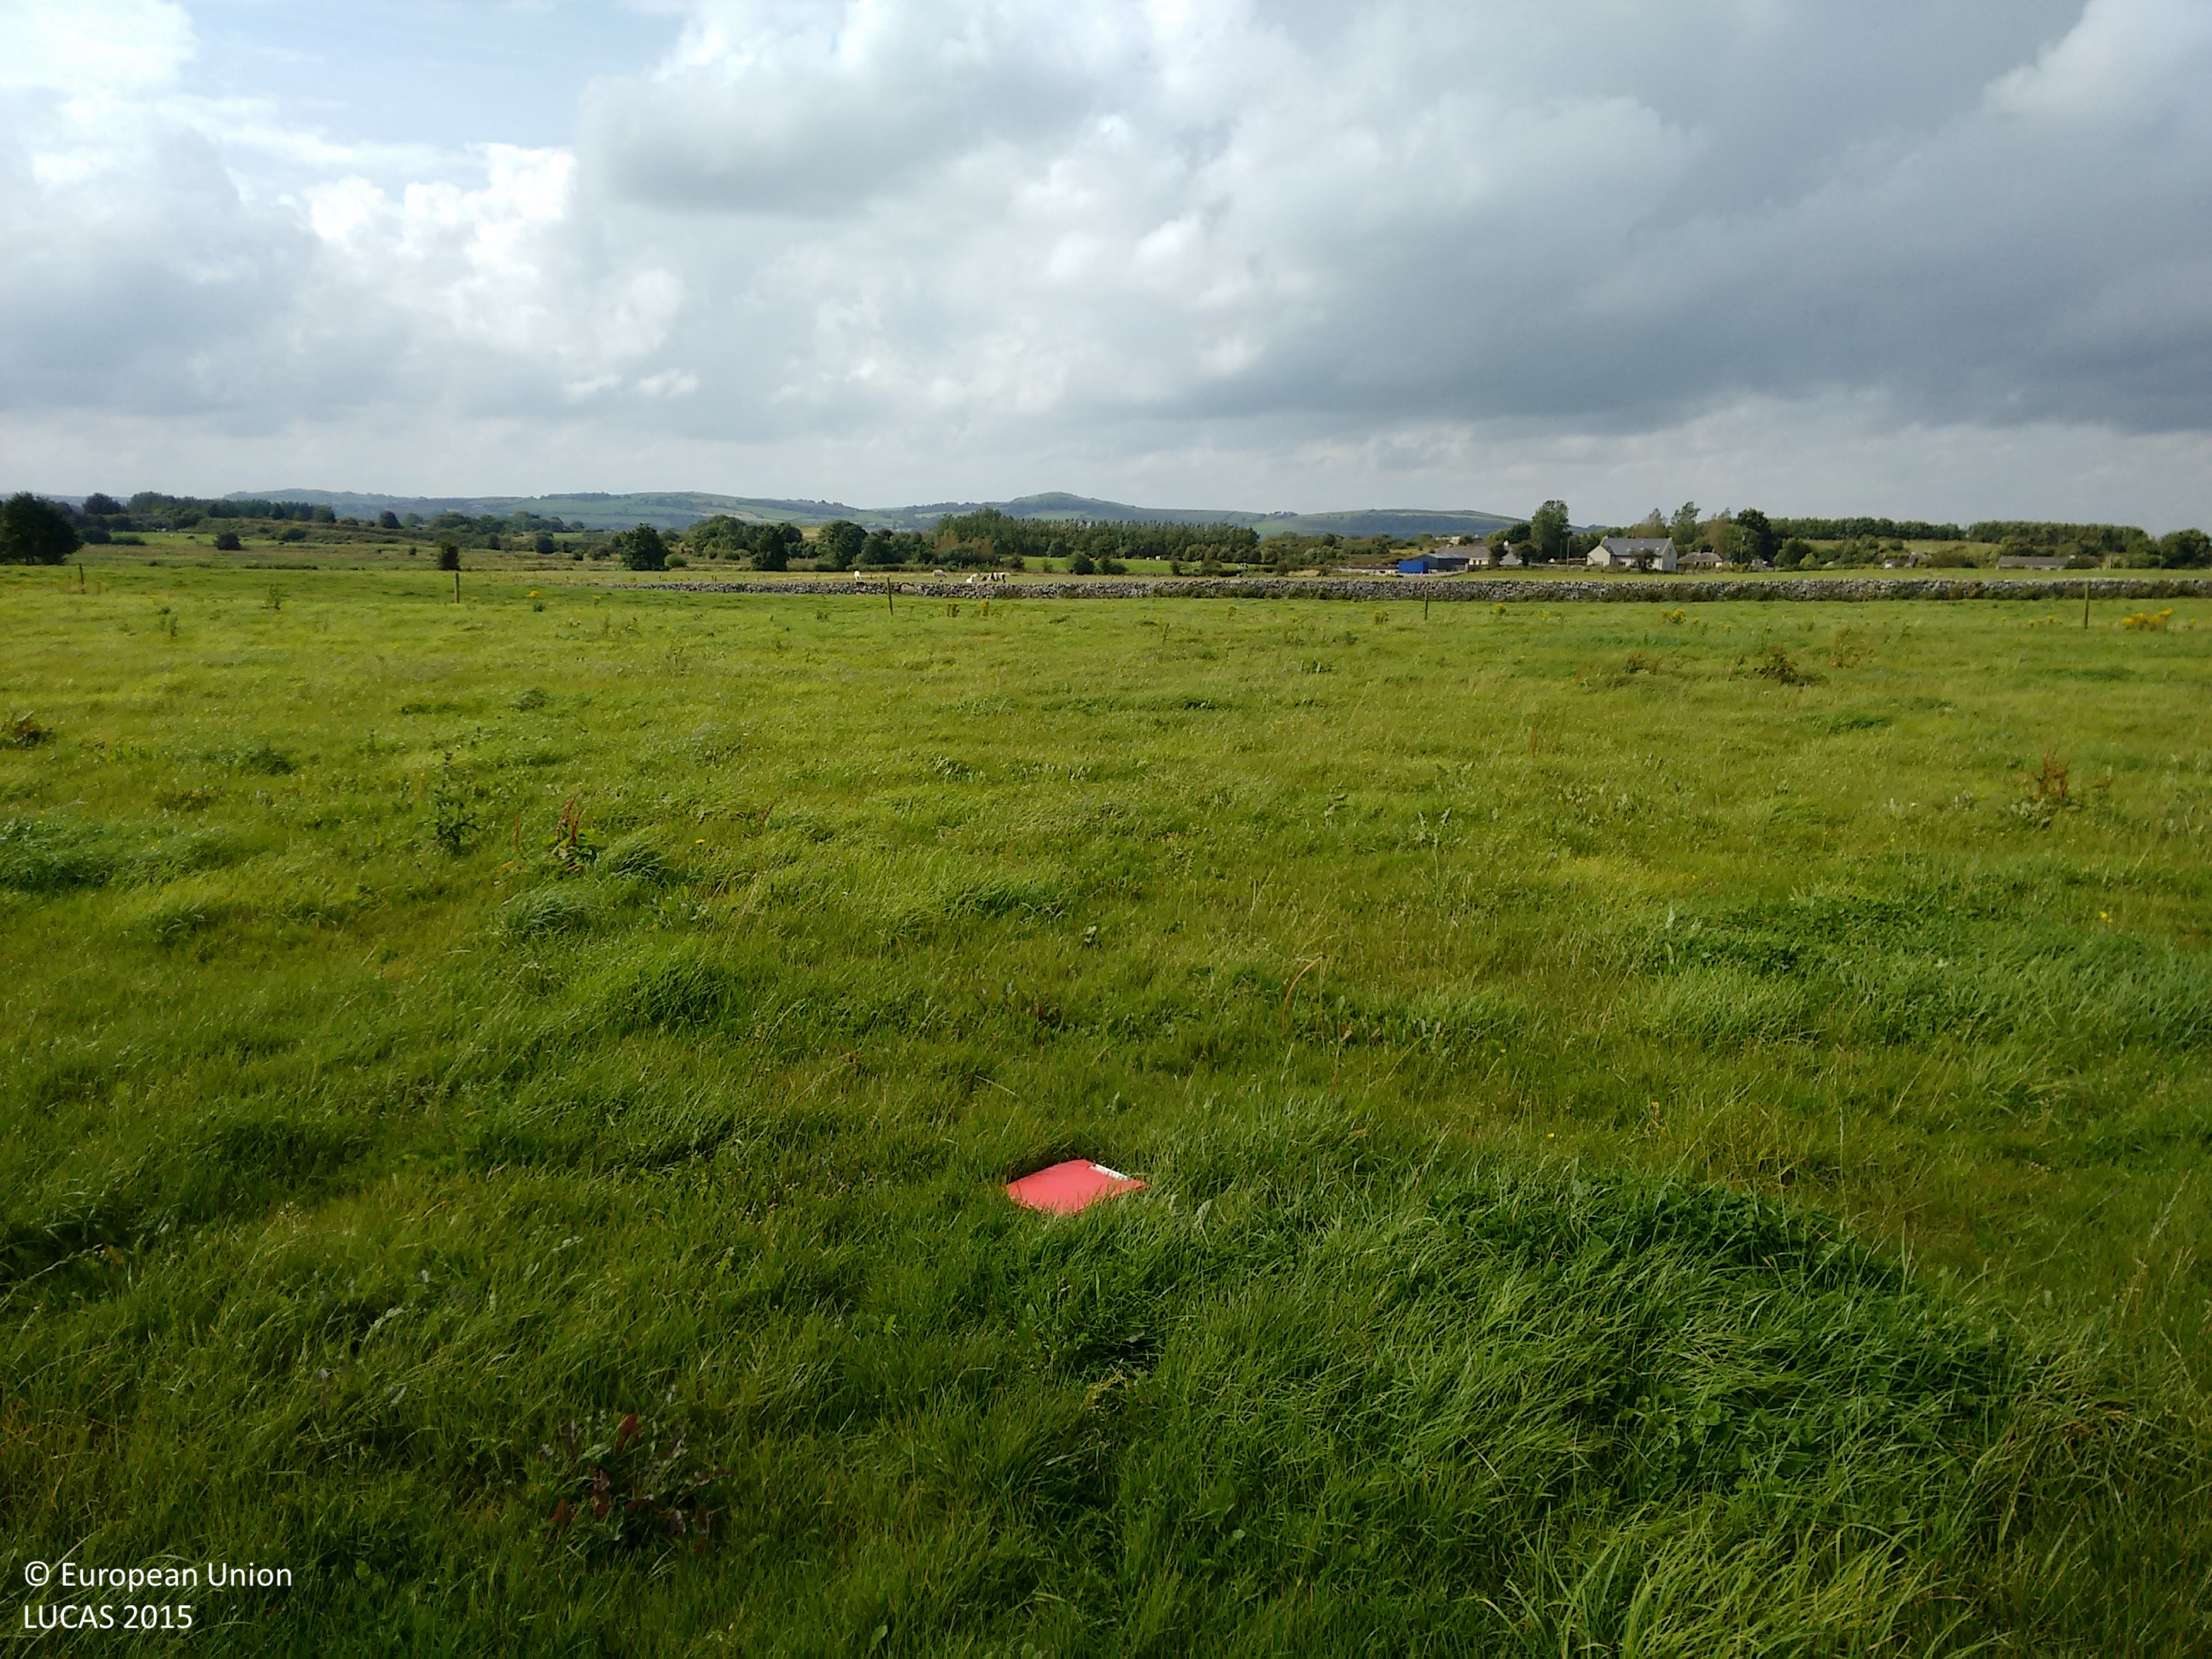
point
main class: Grassland
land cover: Grassland without tree/shrub cover
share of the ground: > 75 %
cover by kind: herbaceous plants 100 %
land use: Agriculture (excluding fallow land and kitchen gardens)
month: September
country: IE
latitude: 52.6095
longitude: -9.0433
